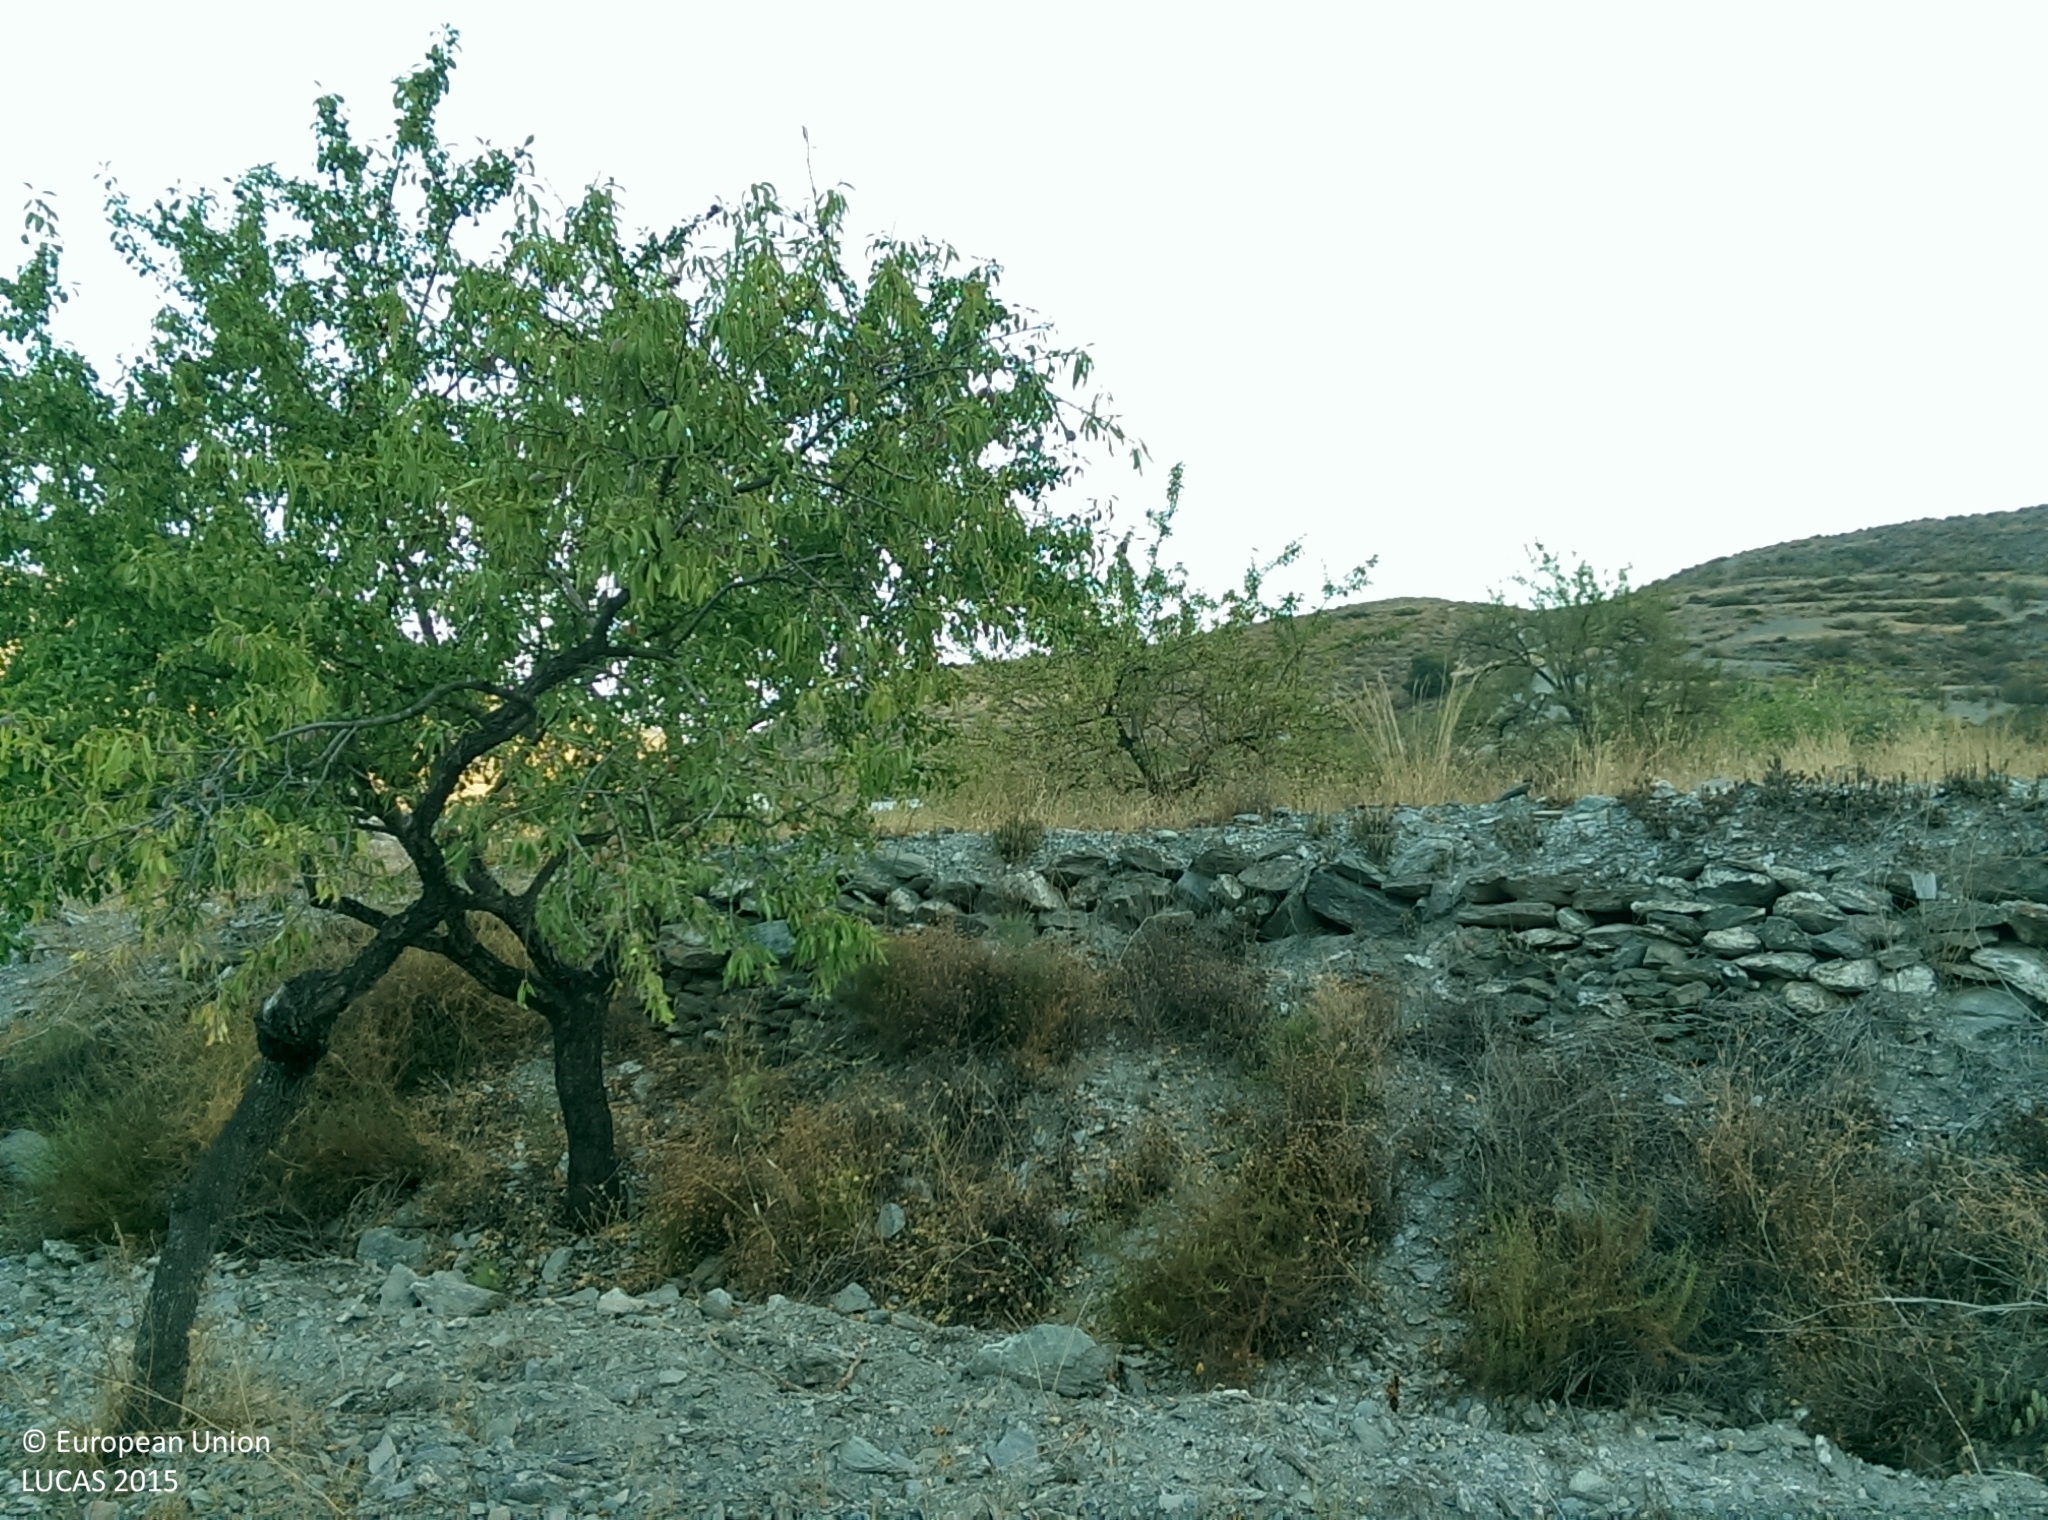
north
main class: Cropland
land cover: Nuts trees
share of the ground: 10 - 25 %
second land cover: Other bare soil
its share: > 75 %
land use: Agriculture (excluding fallow land and kitchen gardens)
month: August
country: ES
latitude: 36.7759
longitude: -3.1438
